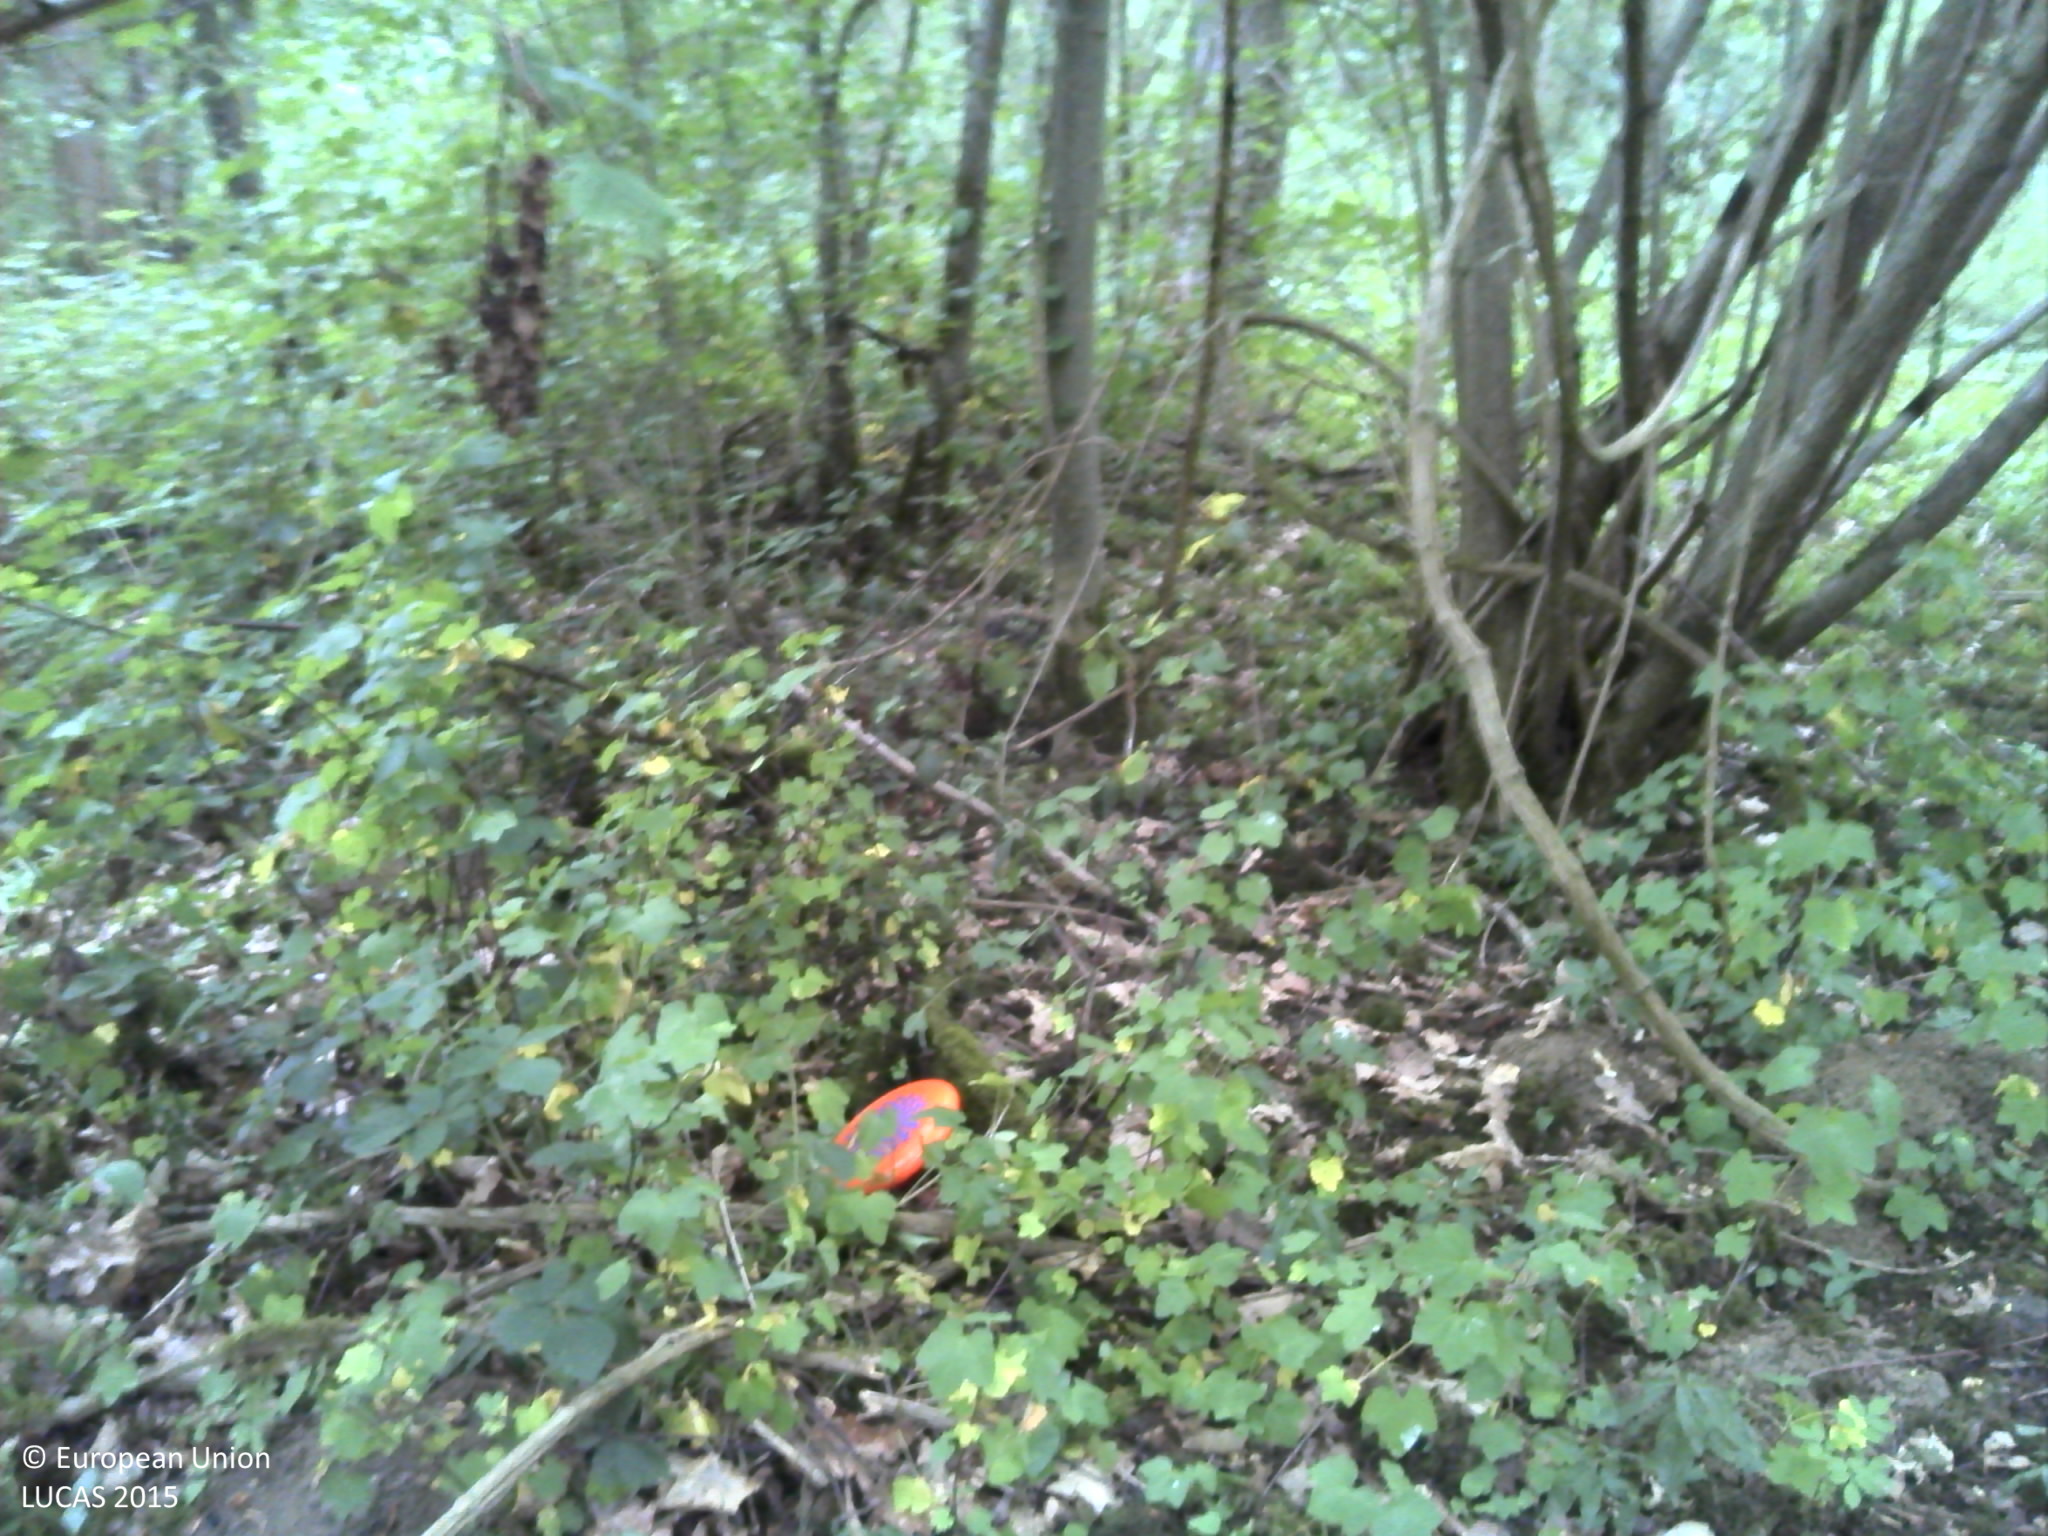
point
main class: Woodland
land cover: Broadleaved woodland
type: floodplain forest
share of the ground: > 75 %
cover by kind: broadleaved forest trees 90 %, herbaceous plants 10 %
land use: Forestry
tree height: > 5 m
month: July
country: FR
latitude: 48.5799
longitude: 2.4660
